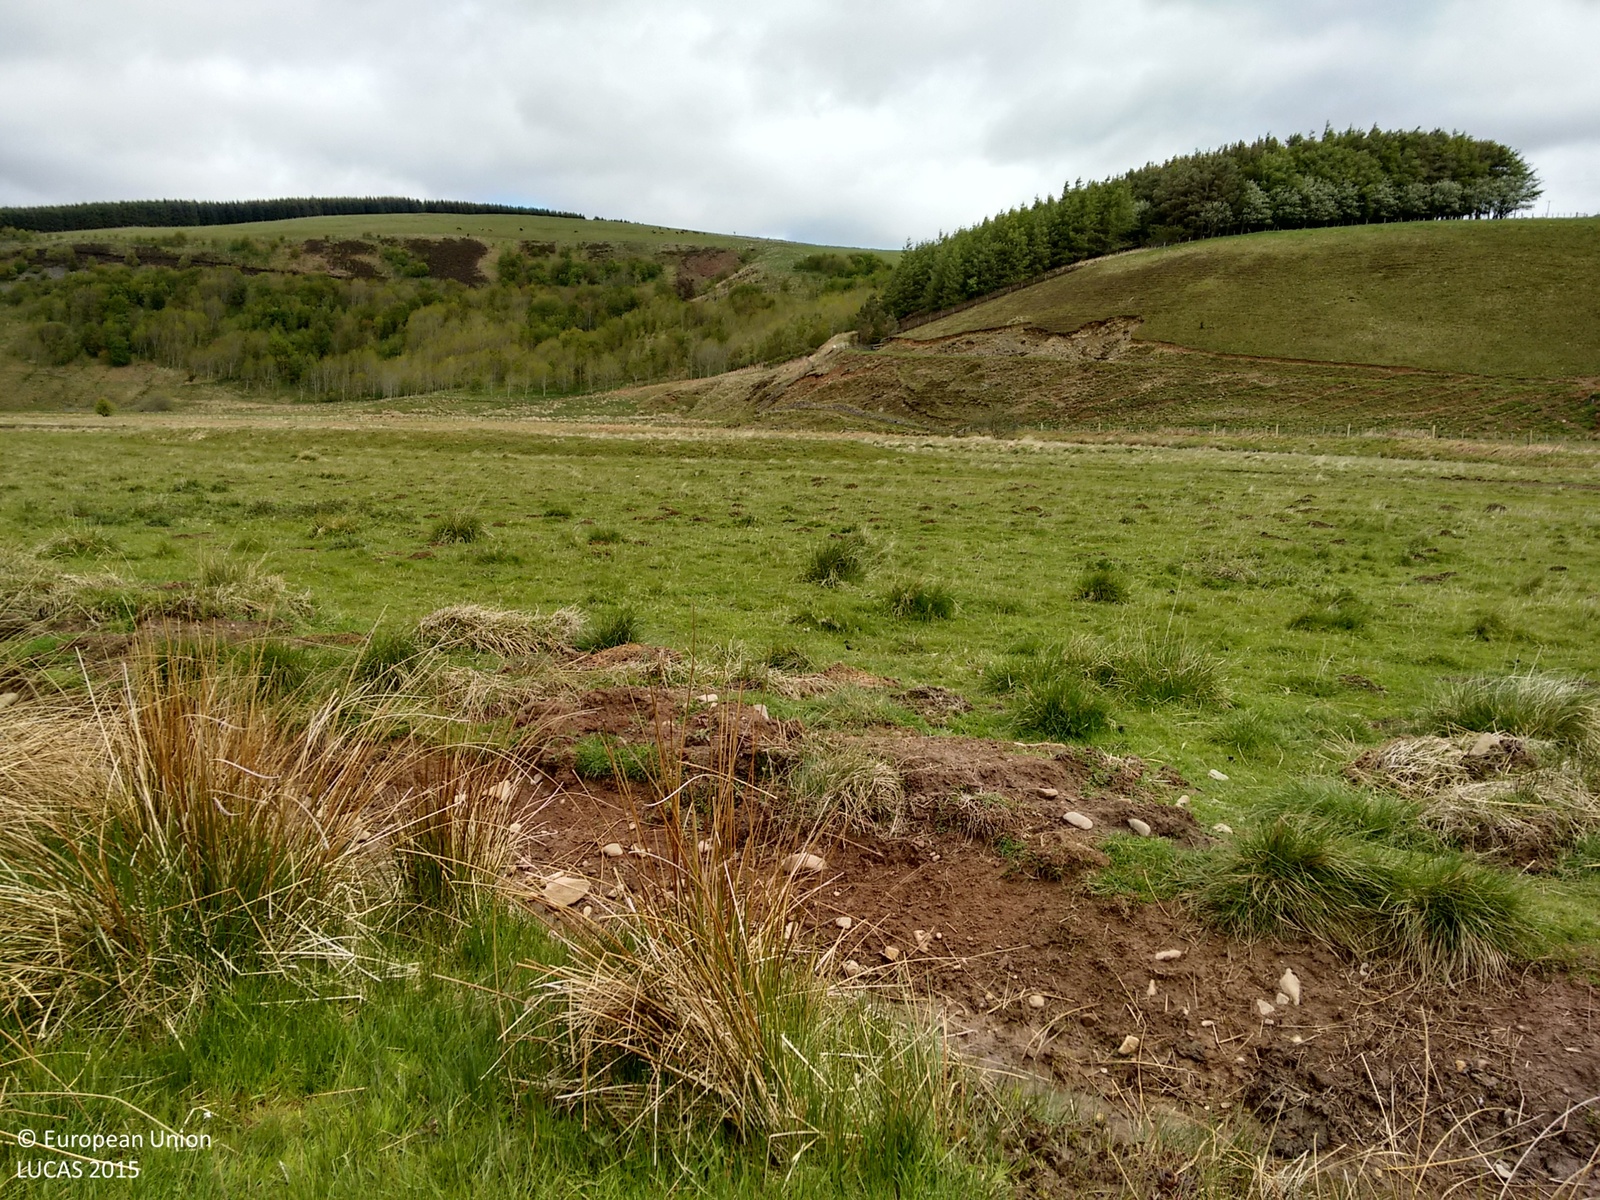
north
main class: Grassland
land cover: Grassland without tree/shrub cover
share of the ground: > 75 %
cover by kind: herbaceous plants 100 %
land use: Agriculture (excluding fallow land and kitchen gardens)
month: June
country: GB
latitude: 55.8820
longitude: -2.5130
